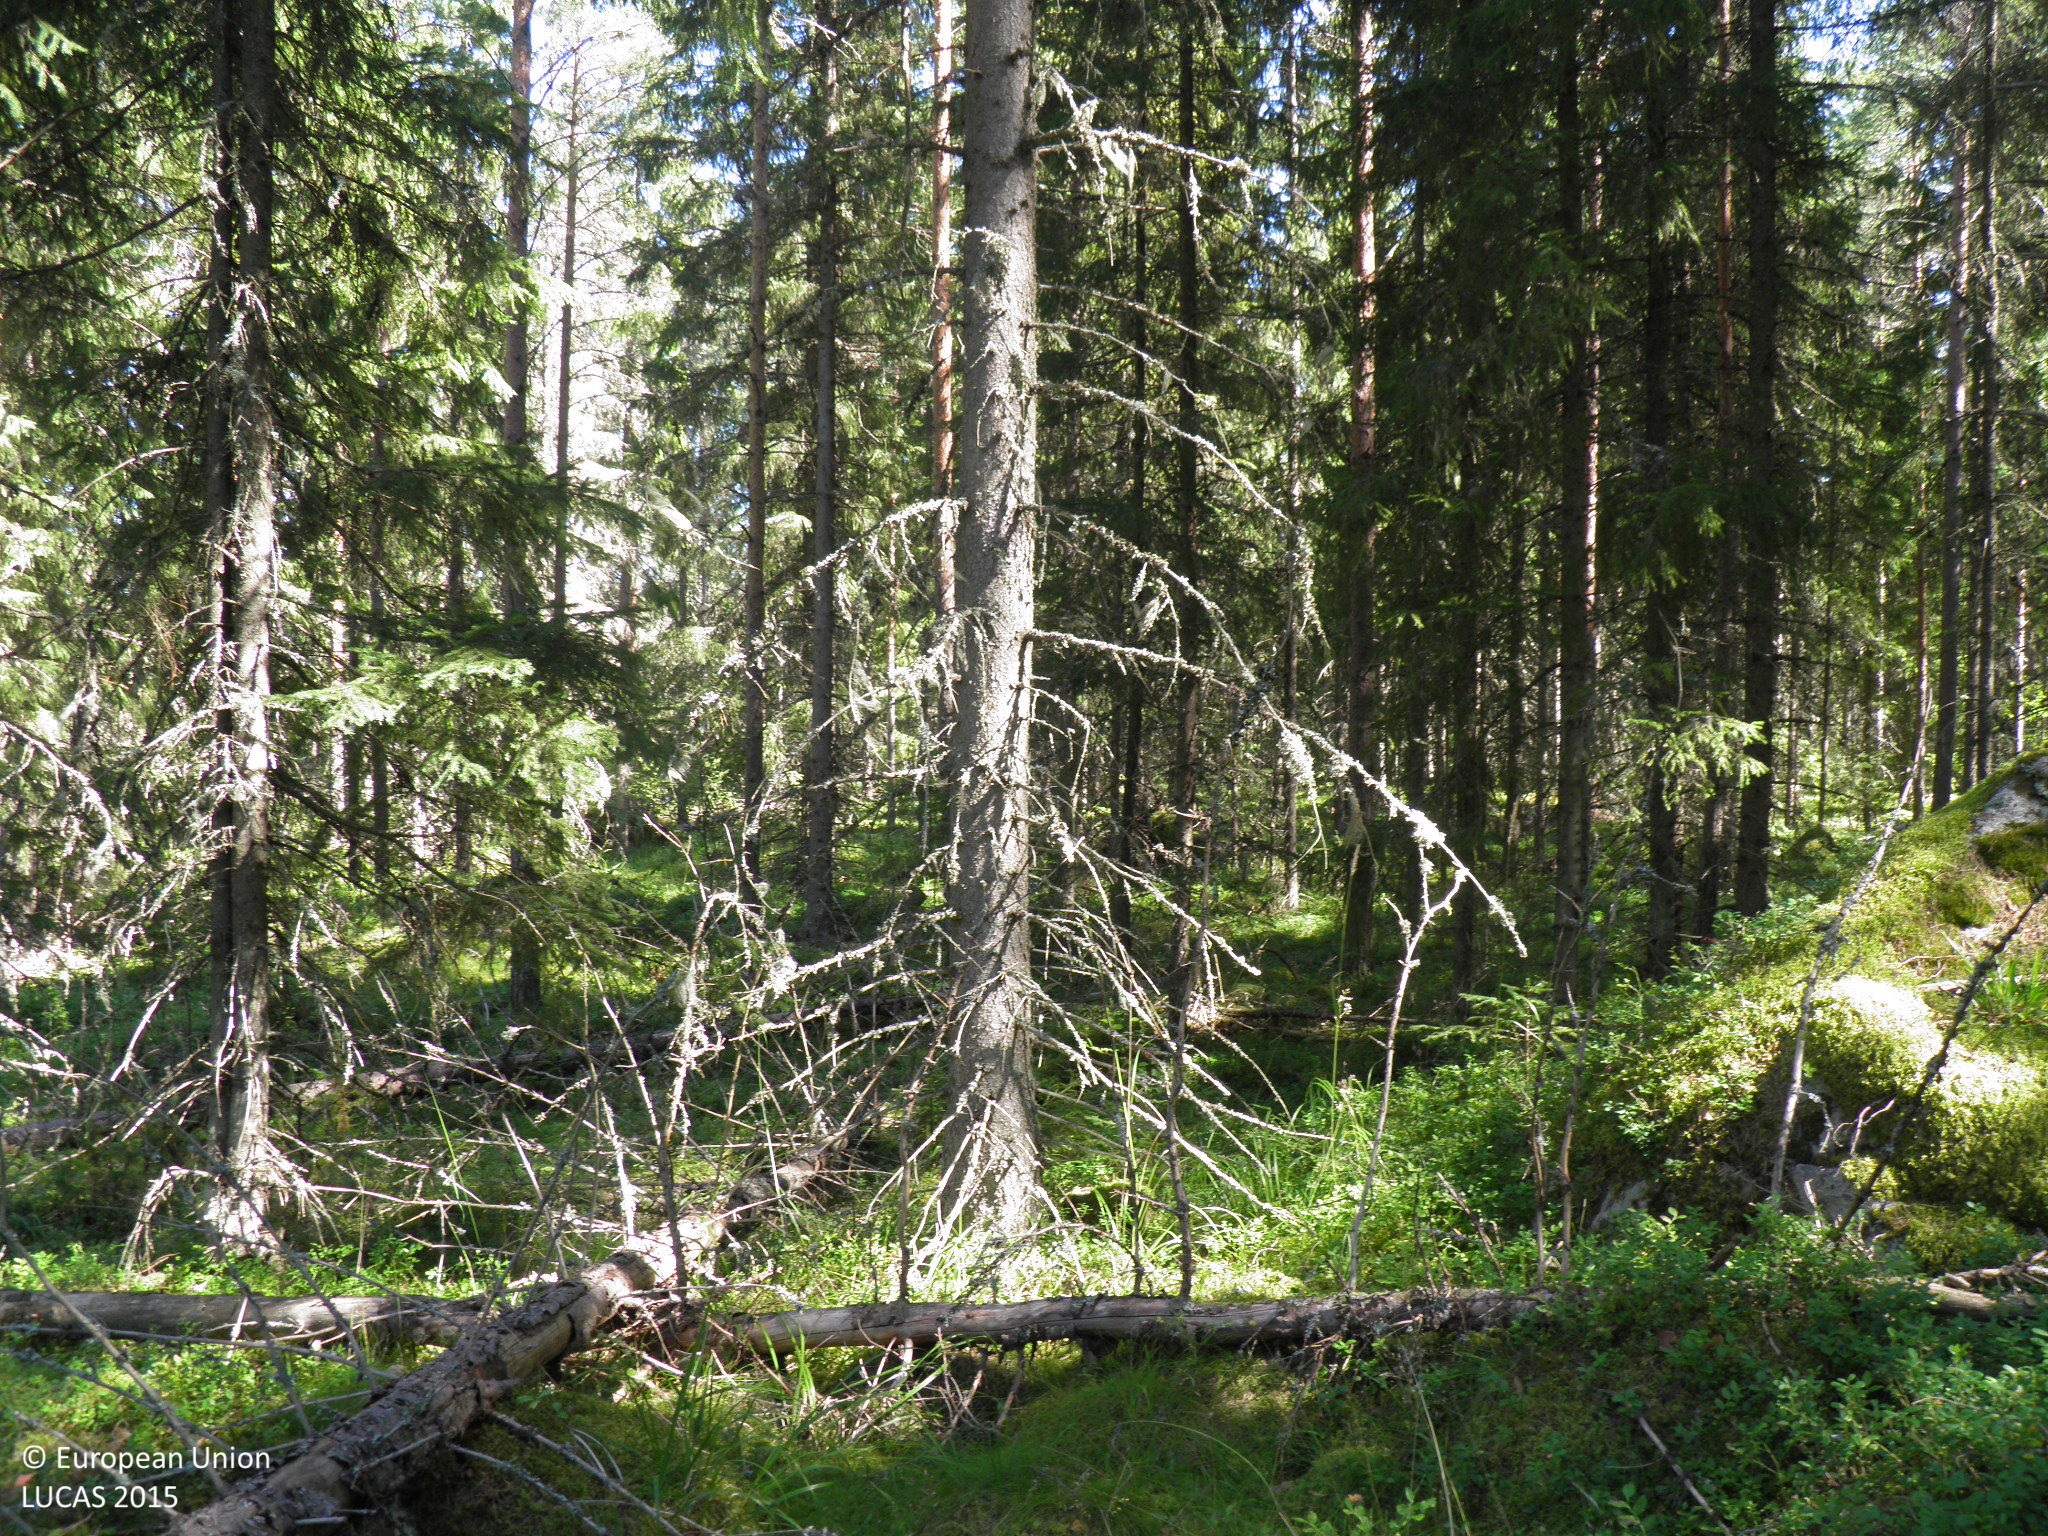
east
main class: Woodland
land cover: Other coniferous woodland
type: hemiboreal forest and nemoral coniferous forest and mixed broadleaved-coniferous forest
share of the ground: 50 - 75 %
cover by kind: coniferous forest trees 50 %, shrubs 20 %, herbaceous plants 20 %, broadleaved forest trees 10 %
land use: Forestry
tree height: > 5 m
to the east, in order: Other coniferous woodland; Ditches and canals; Grass margins; Paved roads, cycling and walking lanes; Grass margins; Ditches and canals; Spruce dominated coniferous woodland
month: August
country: FI
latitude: 60.7570
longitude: 22.0453
